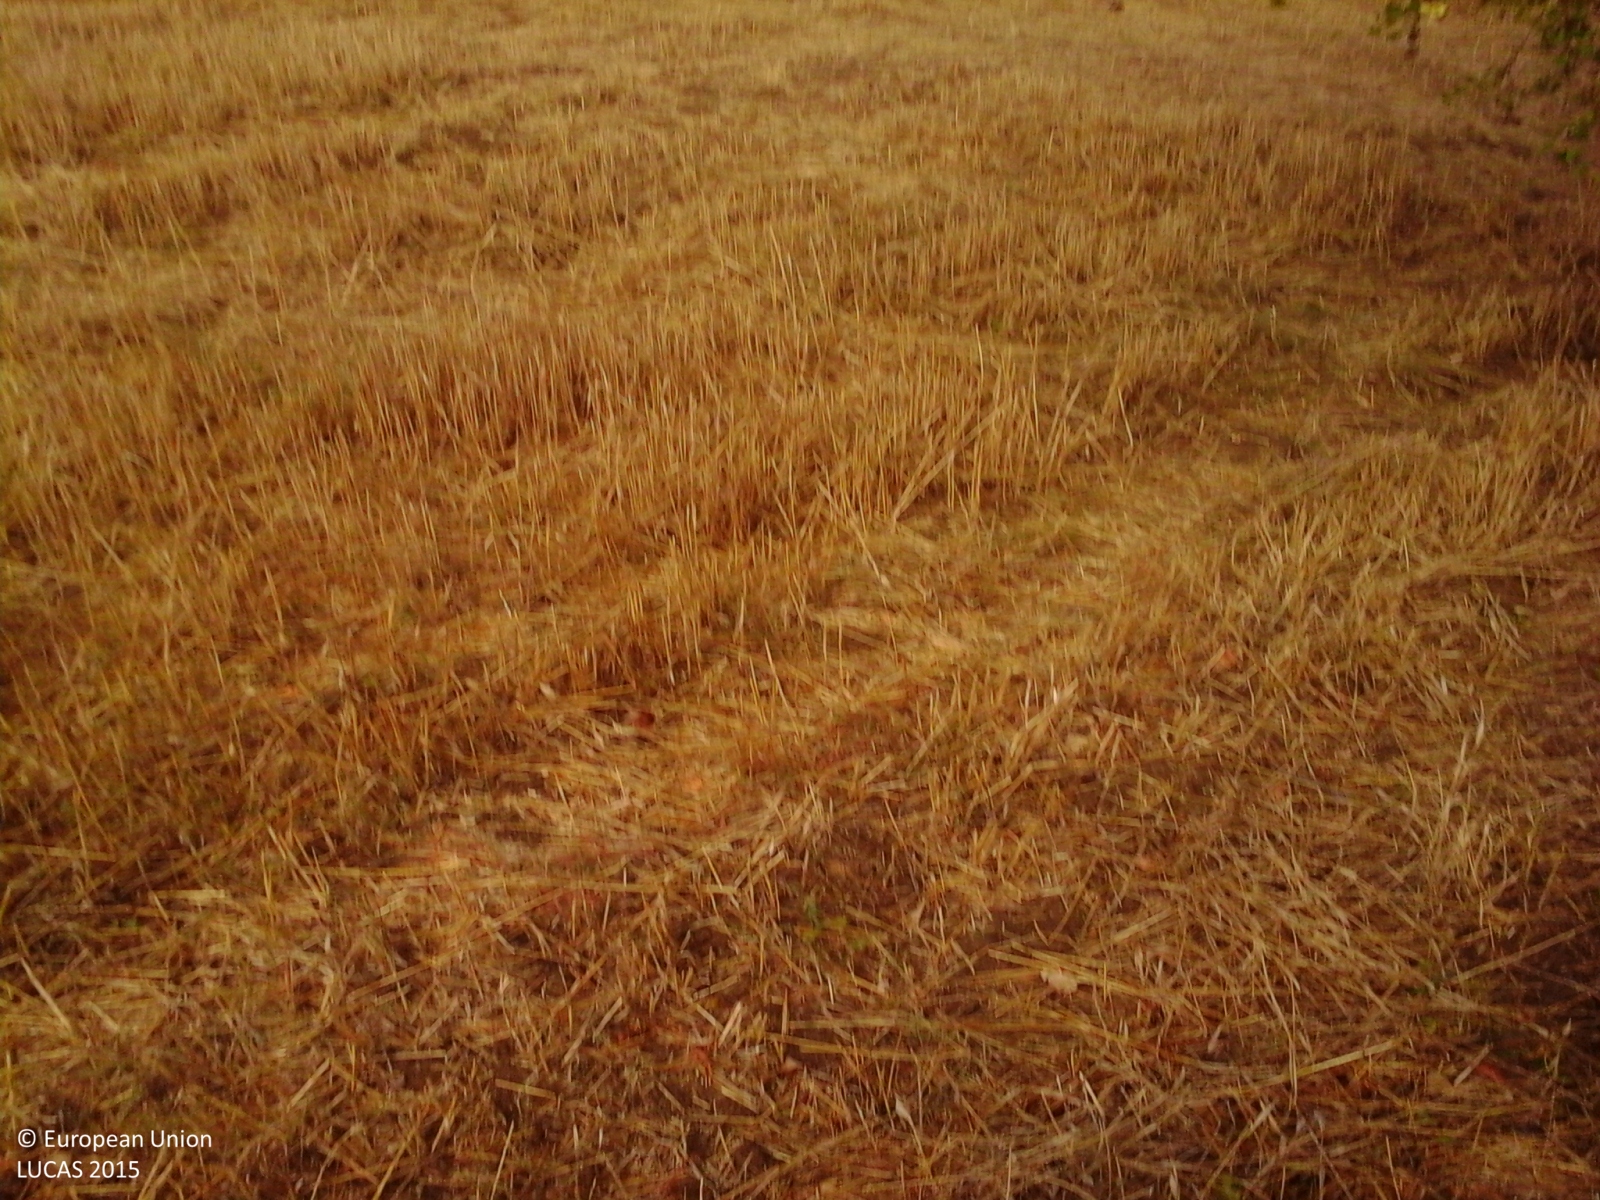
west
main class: Woodland
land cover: Broadleaved woodland
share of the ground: > 75 %
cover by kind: broadleaved forest trees 85 %, shrubs 15 %
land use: Semi-natural and natural areas not in use
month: August
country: IT
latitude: 42.5892
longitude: 11.4695
